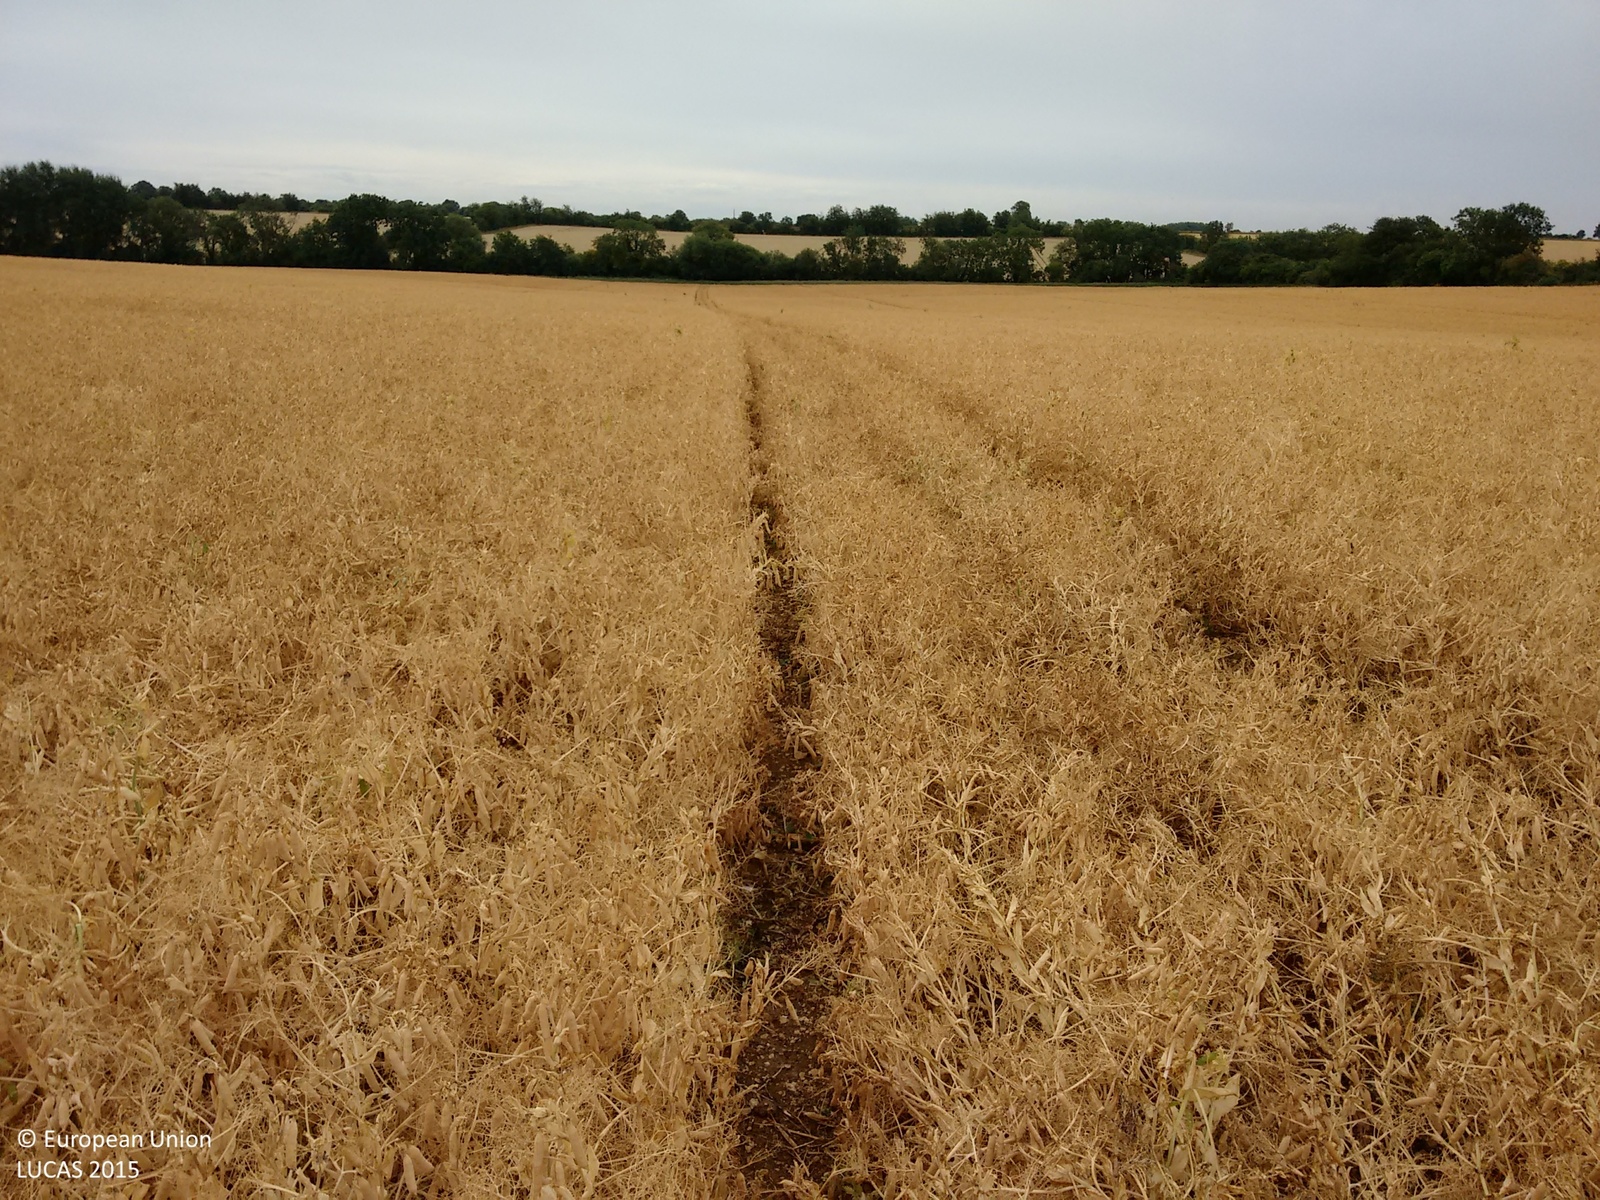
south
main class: Cropland
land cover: Dry pulses
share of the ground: > 75 %
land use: Agriculture (excluding fallow land and kitchen gardens)
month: August
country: GB
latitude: 52.0275
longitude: -1.1967
